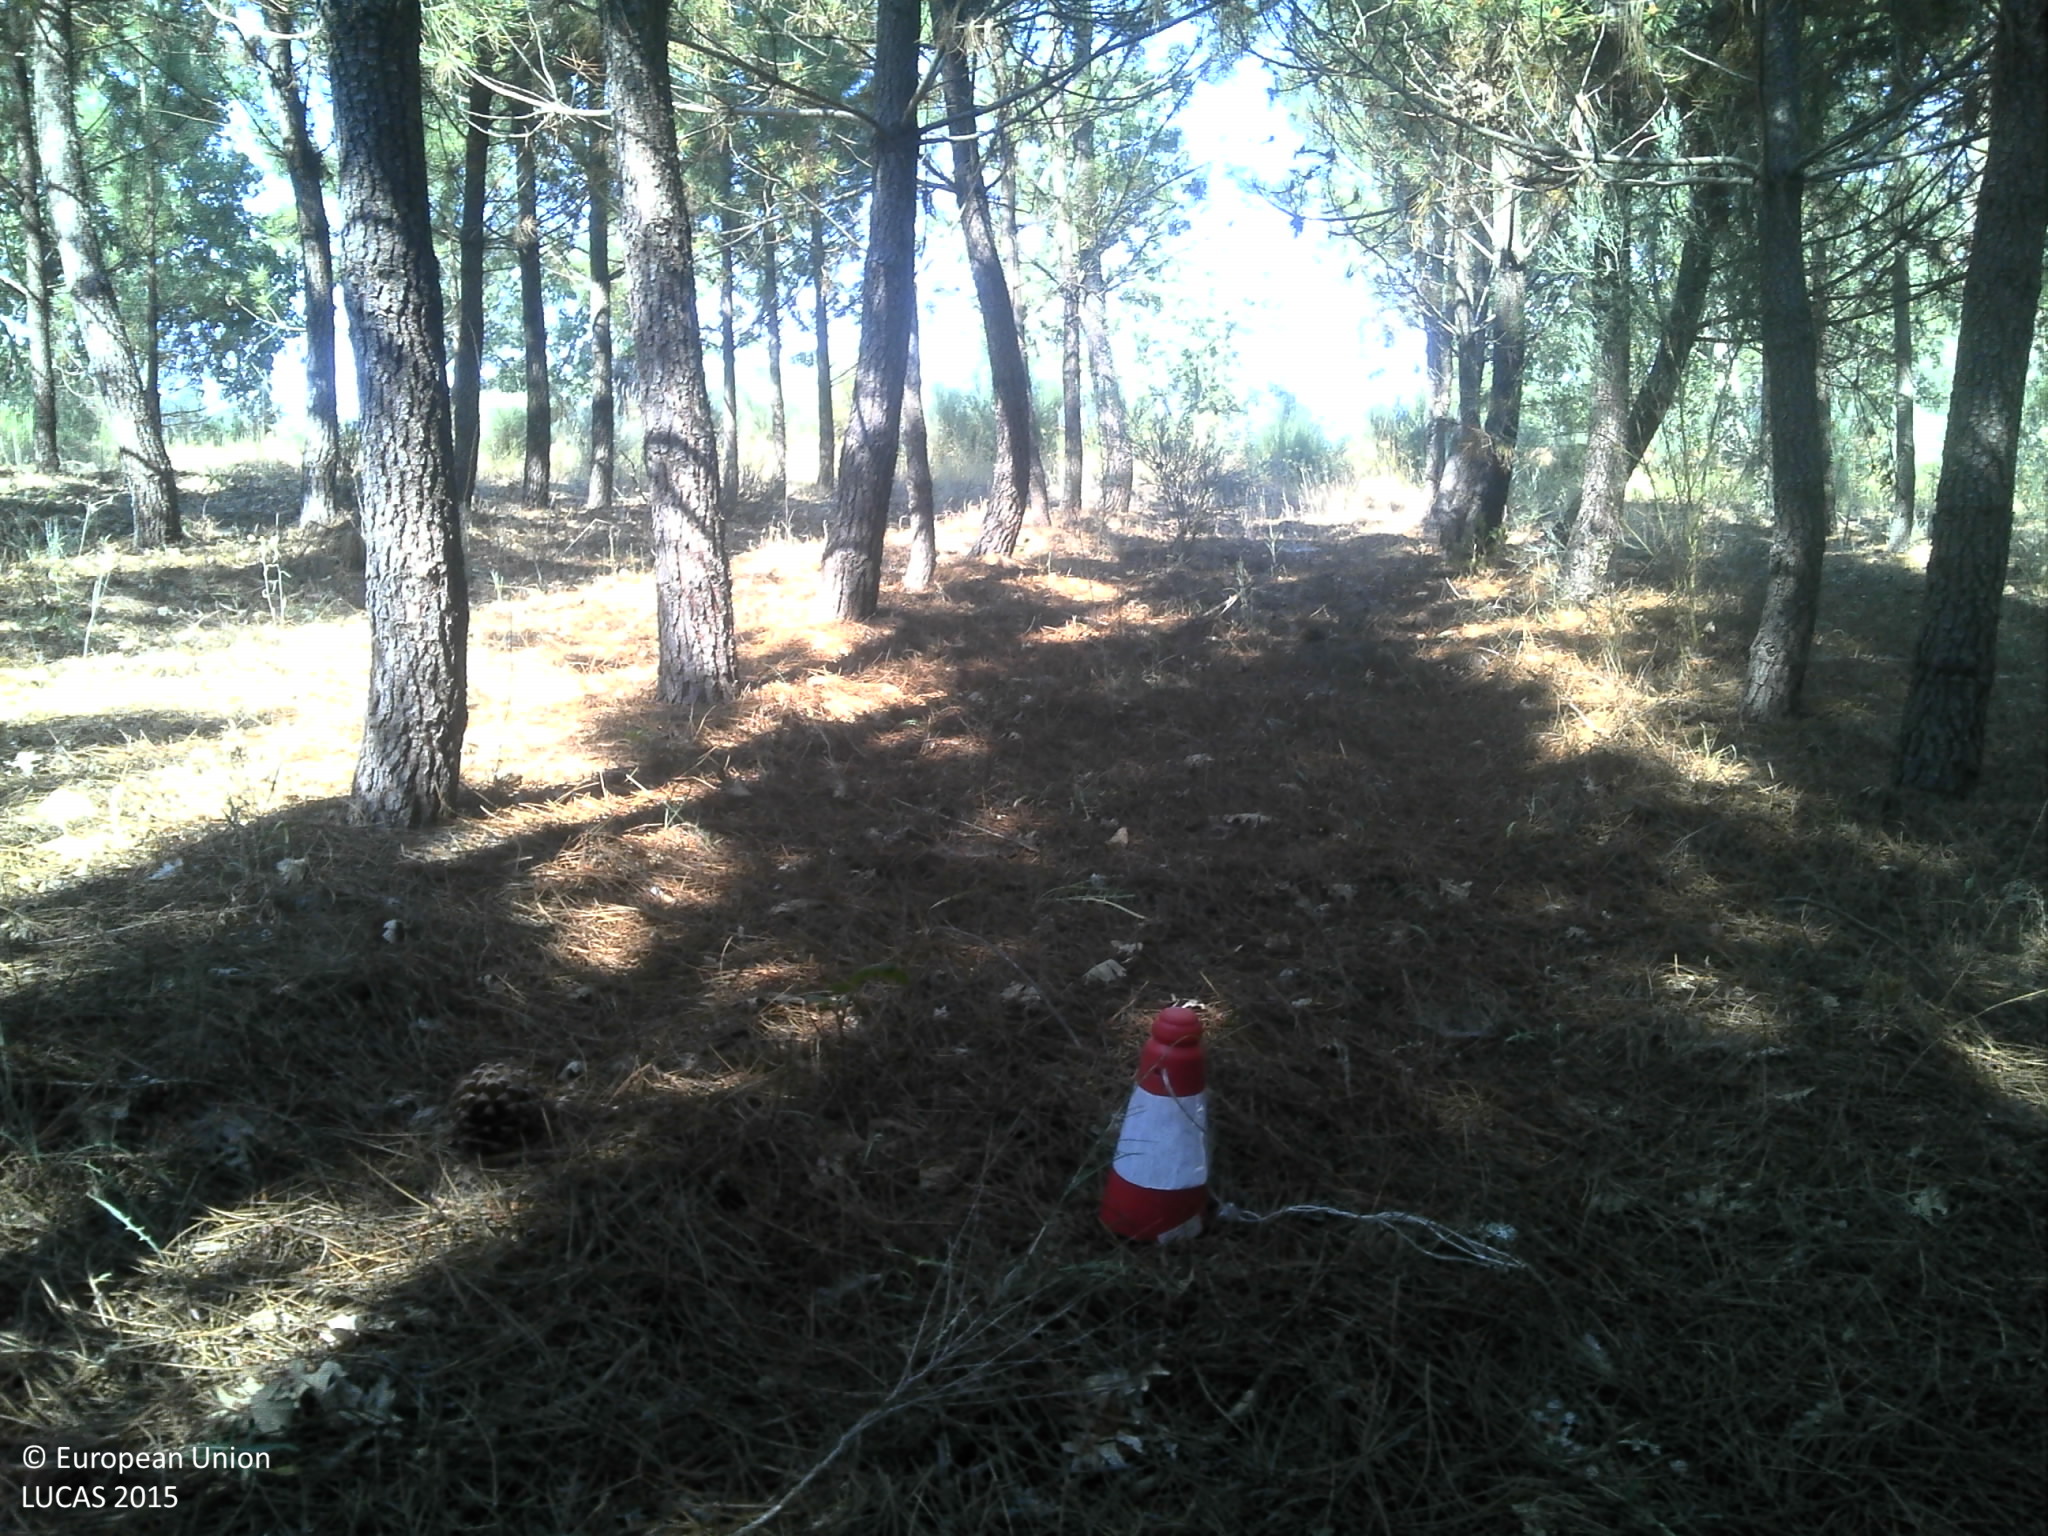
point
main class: Woodland
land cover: Pine dominated coniferous woodland
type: coniferous forest of the mediterranean region
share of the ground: 50 - 75 %
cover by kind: coniferous forest trees 75 %, unconsolidated bare surface 20 %, herbaceous plants 5 %
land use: Forestry
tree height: > 5 m
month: June
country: PT
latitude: 40.3798
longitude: -6.9752
